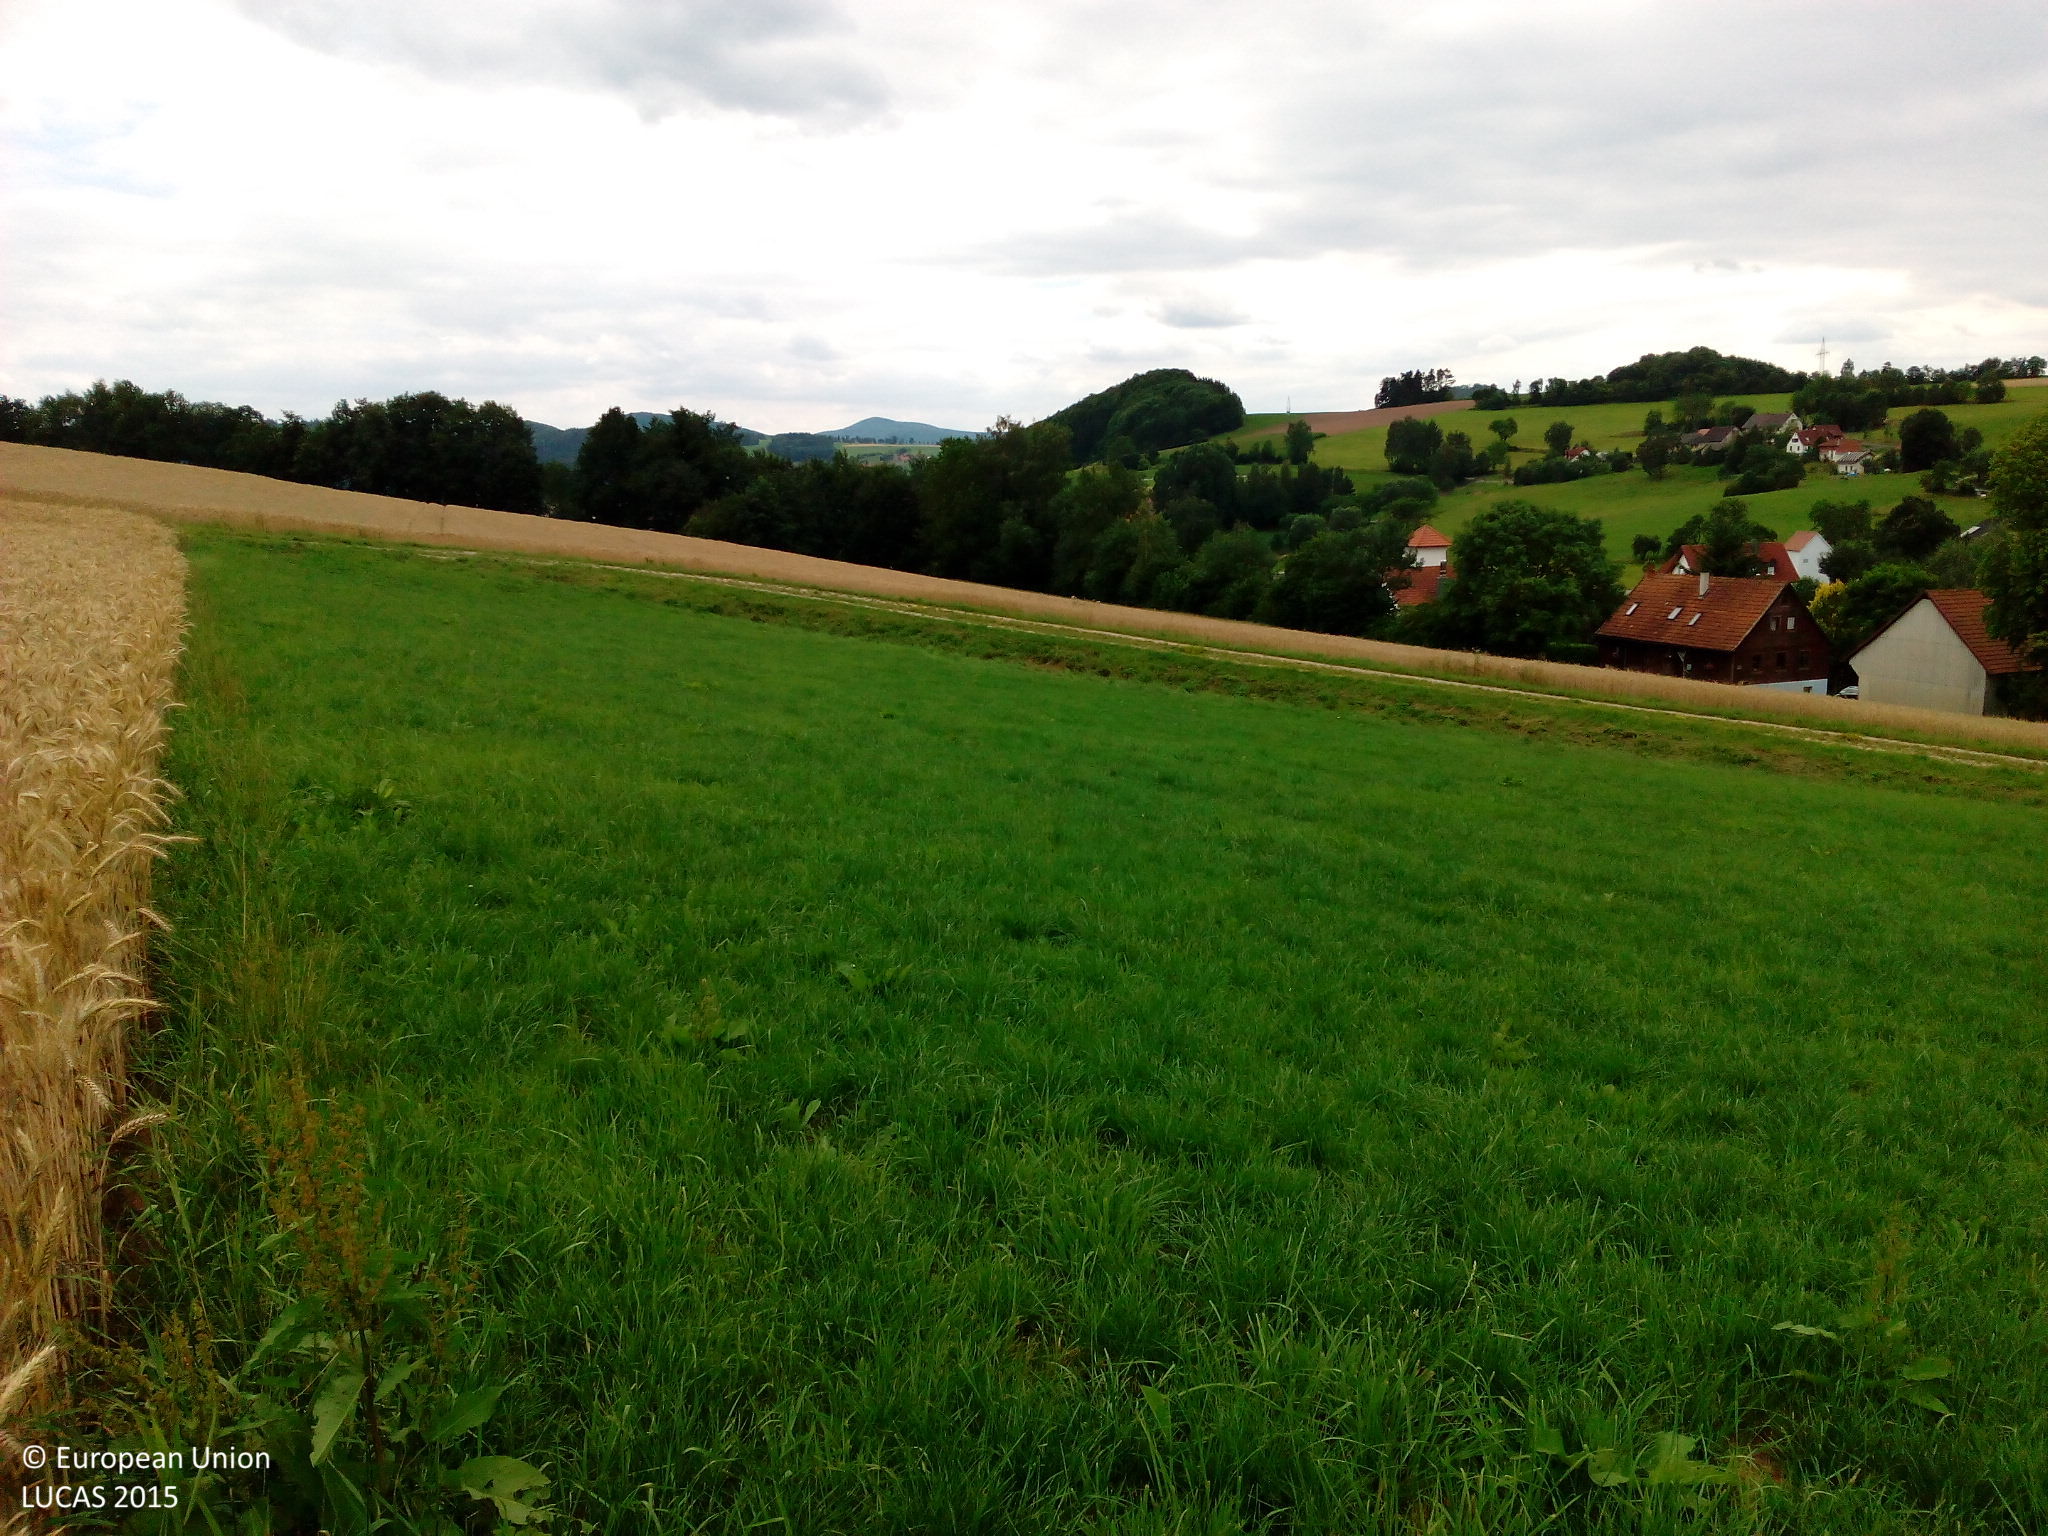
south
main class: Cropland
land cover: Barley
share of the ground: > 75 %
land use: Agriculture (excluding fallow land and kitchen gardens)
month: July
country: DE
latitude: 50.5078
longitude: 9.8731
